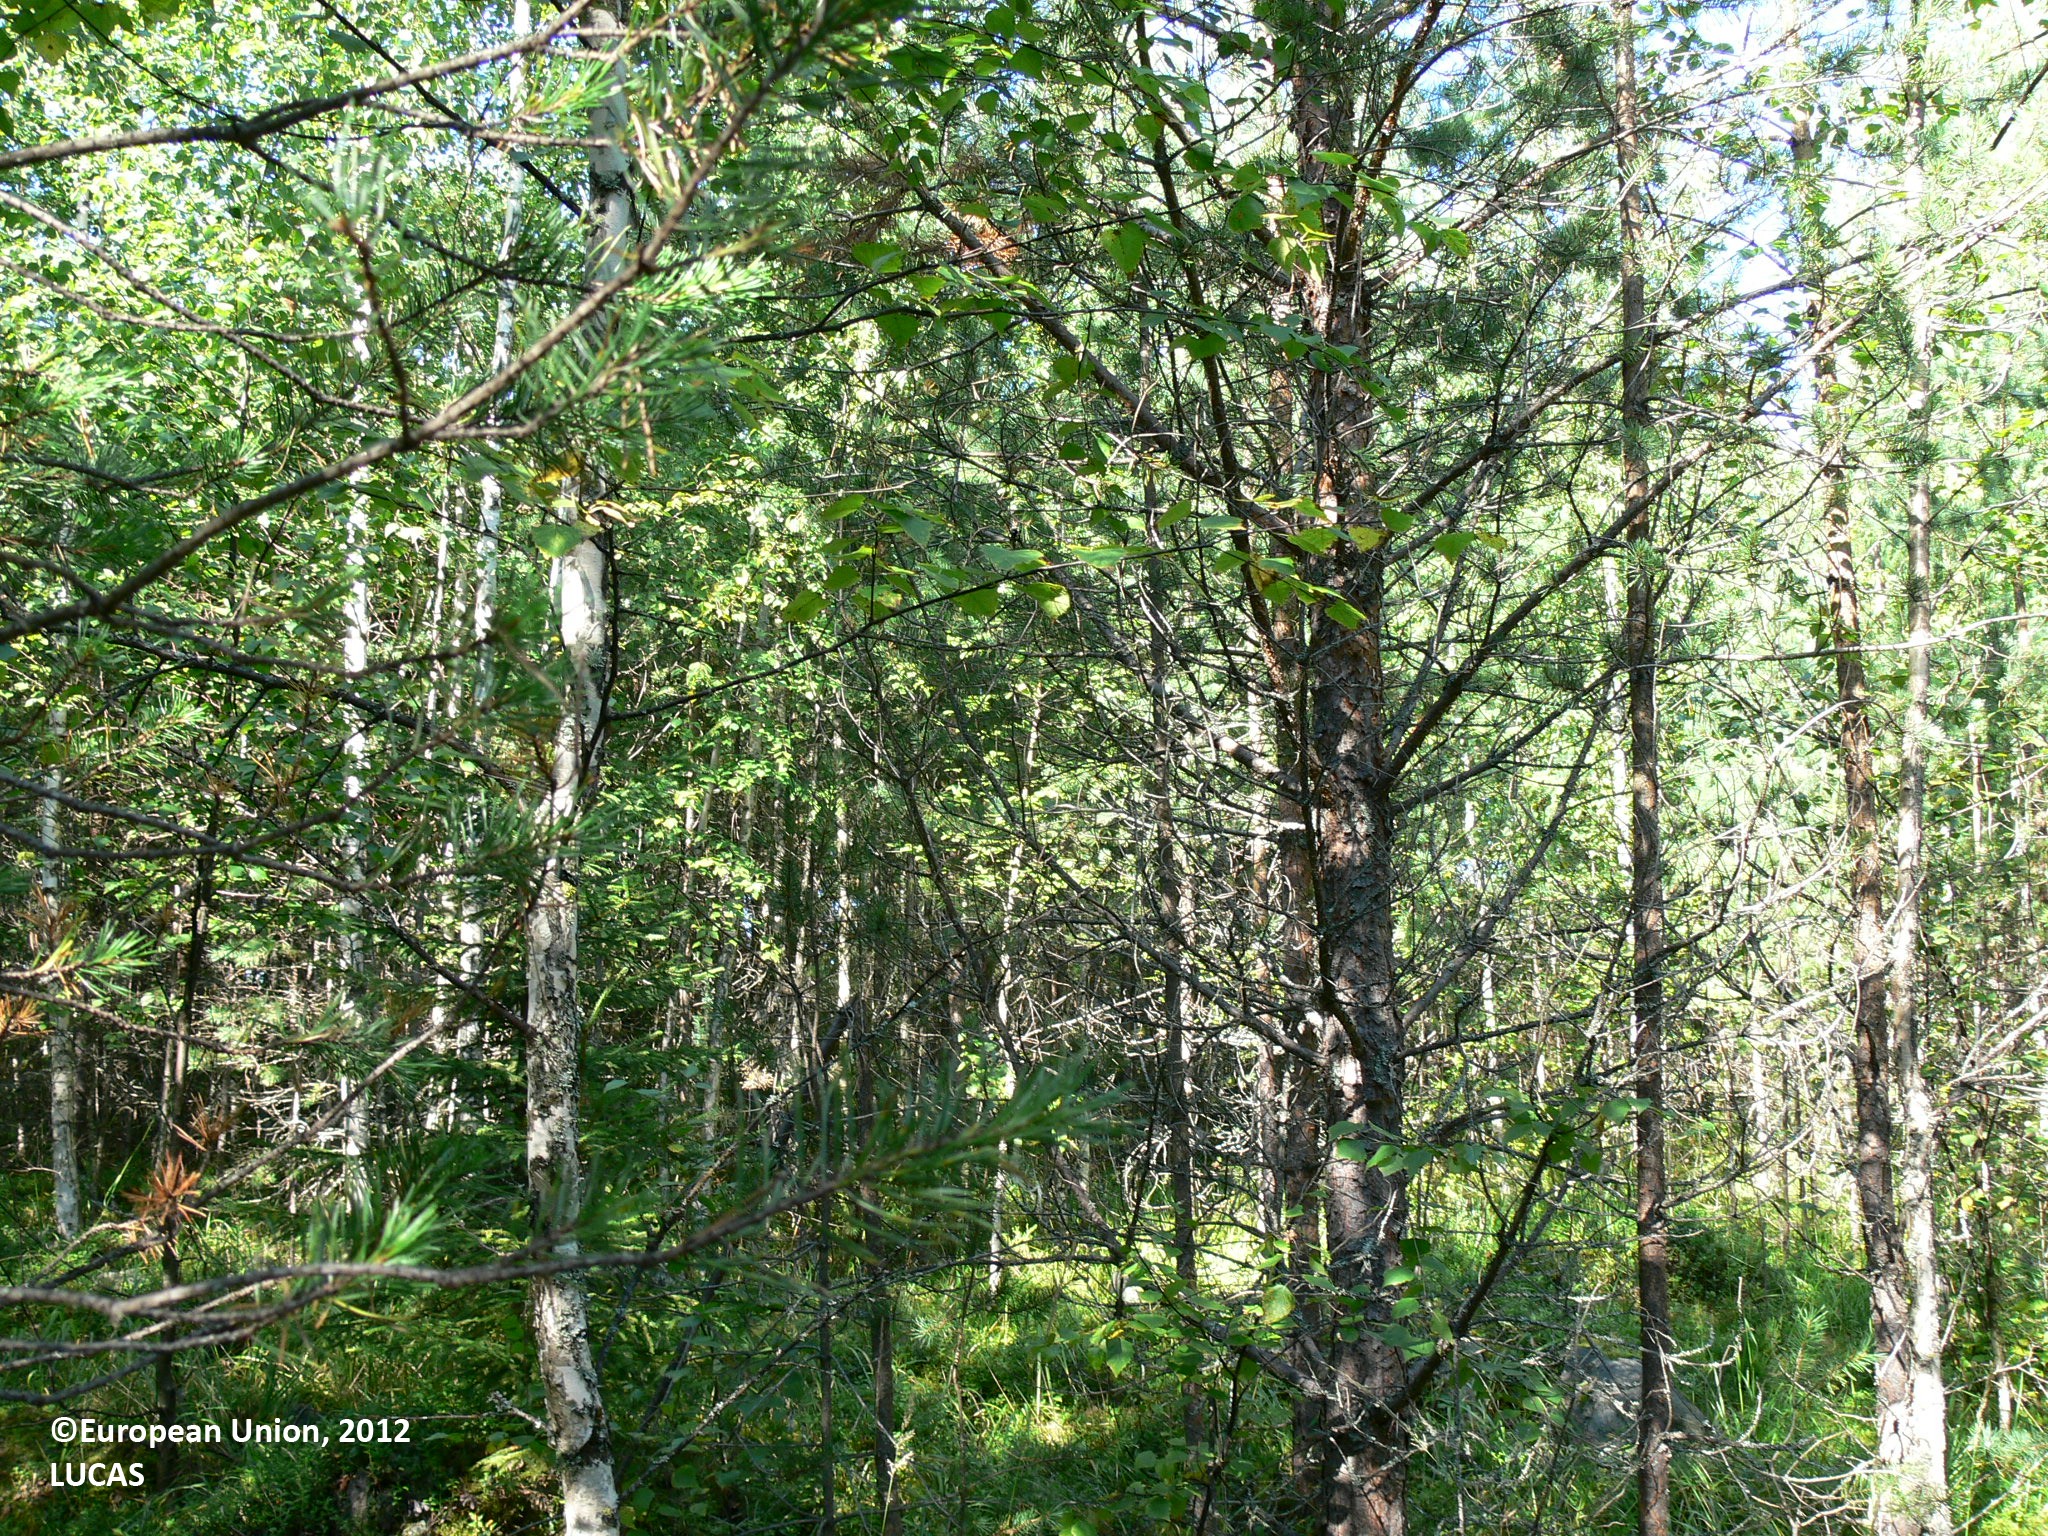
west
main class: Woodland
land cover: Pine dominated mixed woodland
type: boreal forest
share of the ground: 50 - 75 %
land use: Forestry
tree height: > 5 m
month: August
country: FI
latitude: 63.1560
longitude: 29.5885
